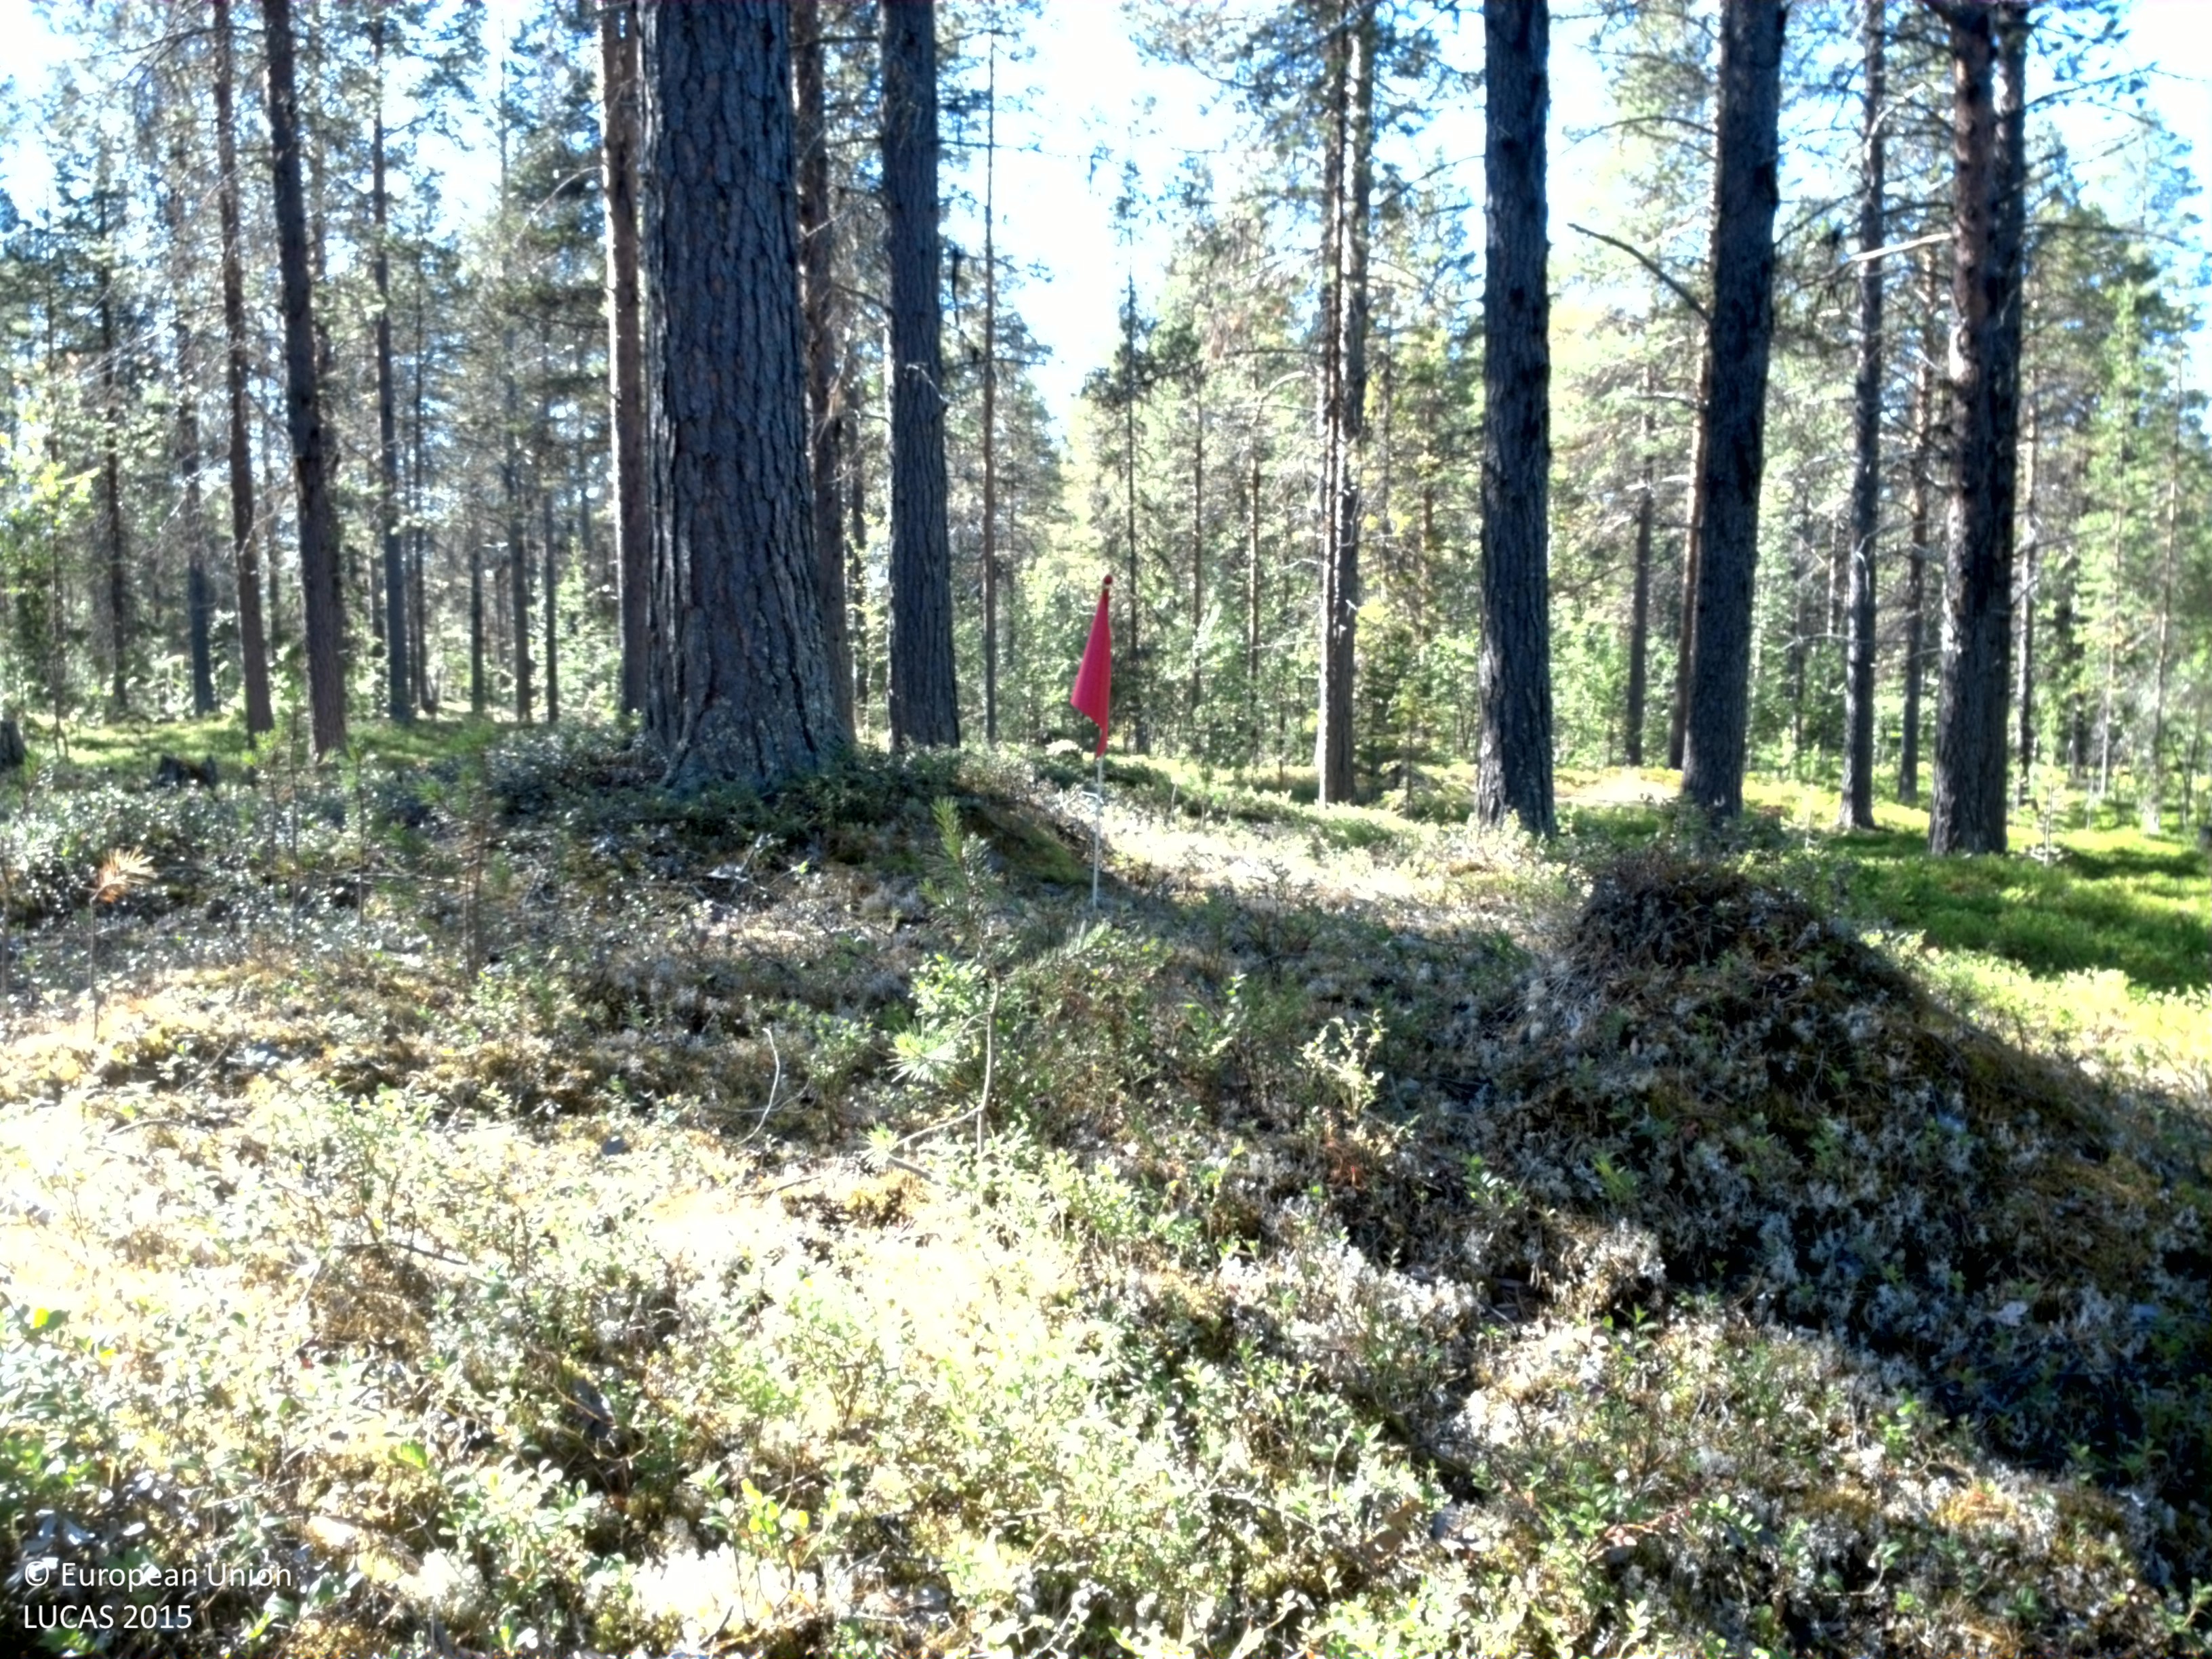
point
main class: Woodland
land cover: Pine dominated coniferous woodland
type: boreal forest
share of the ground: 25 - 50 %
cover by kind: shrubs 55 %, coniferous forest trees 35 %, broadleaved forest trees 5 %, lichens and mosses 5 %
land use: Forestry
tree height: > 5 m
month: August
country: SE
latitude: 66.6847
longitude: 18.8024
